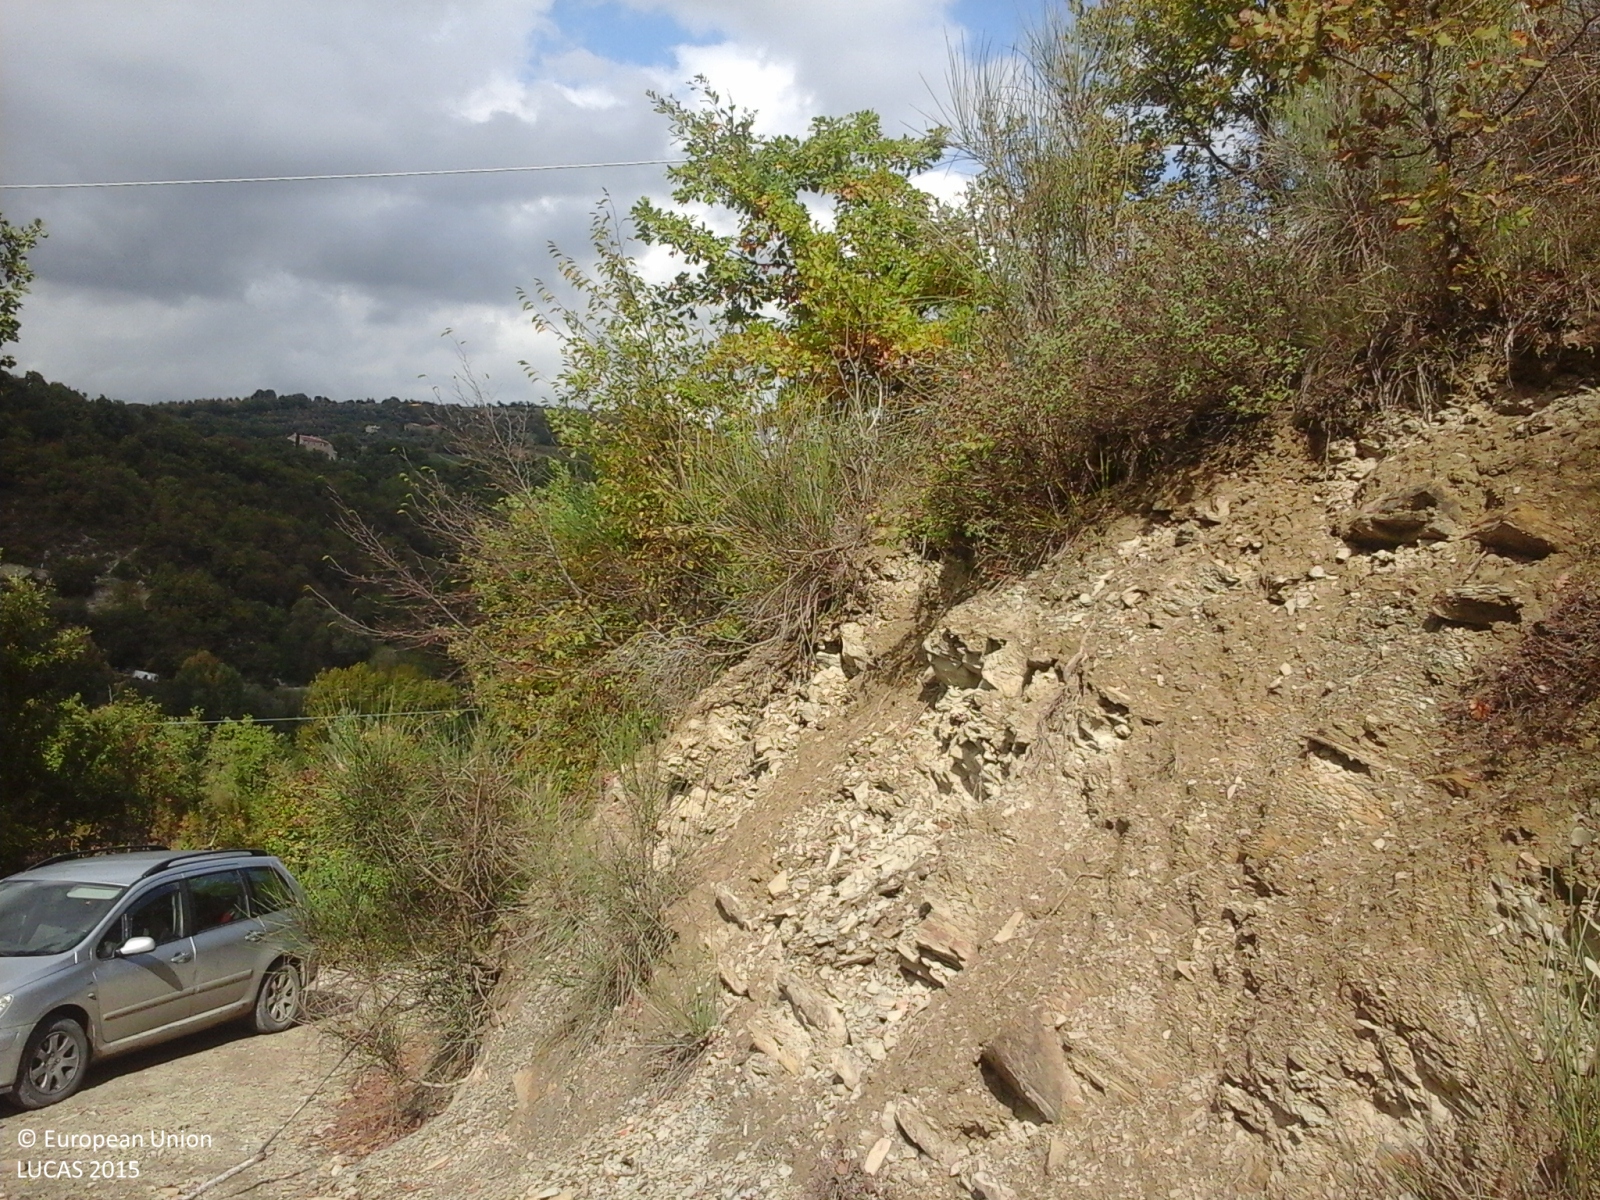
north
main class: Woodland
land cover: Broadleaved woodland
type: thermophilous deciduous forest
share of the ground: > 75 %
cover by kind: broadleaved forest trees 100 %
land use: Forestry
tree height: > 5 m
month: October
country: IT
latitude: 43.4411
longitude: 12.2796
